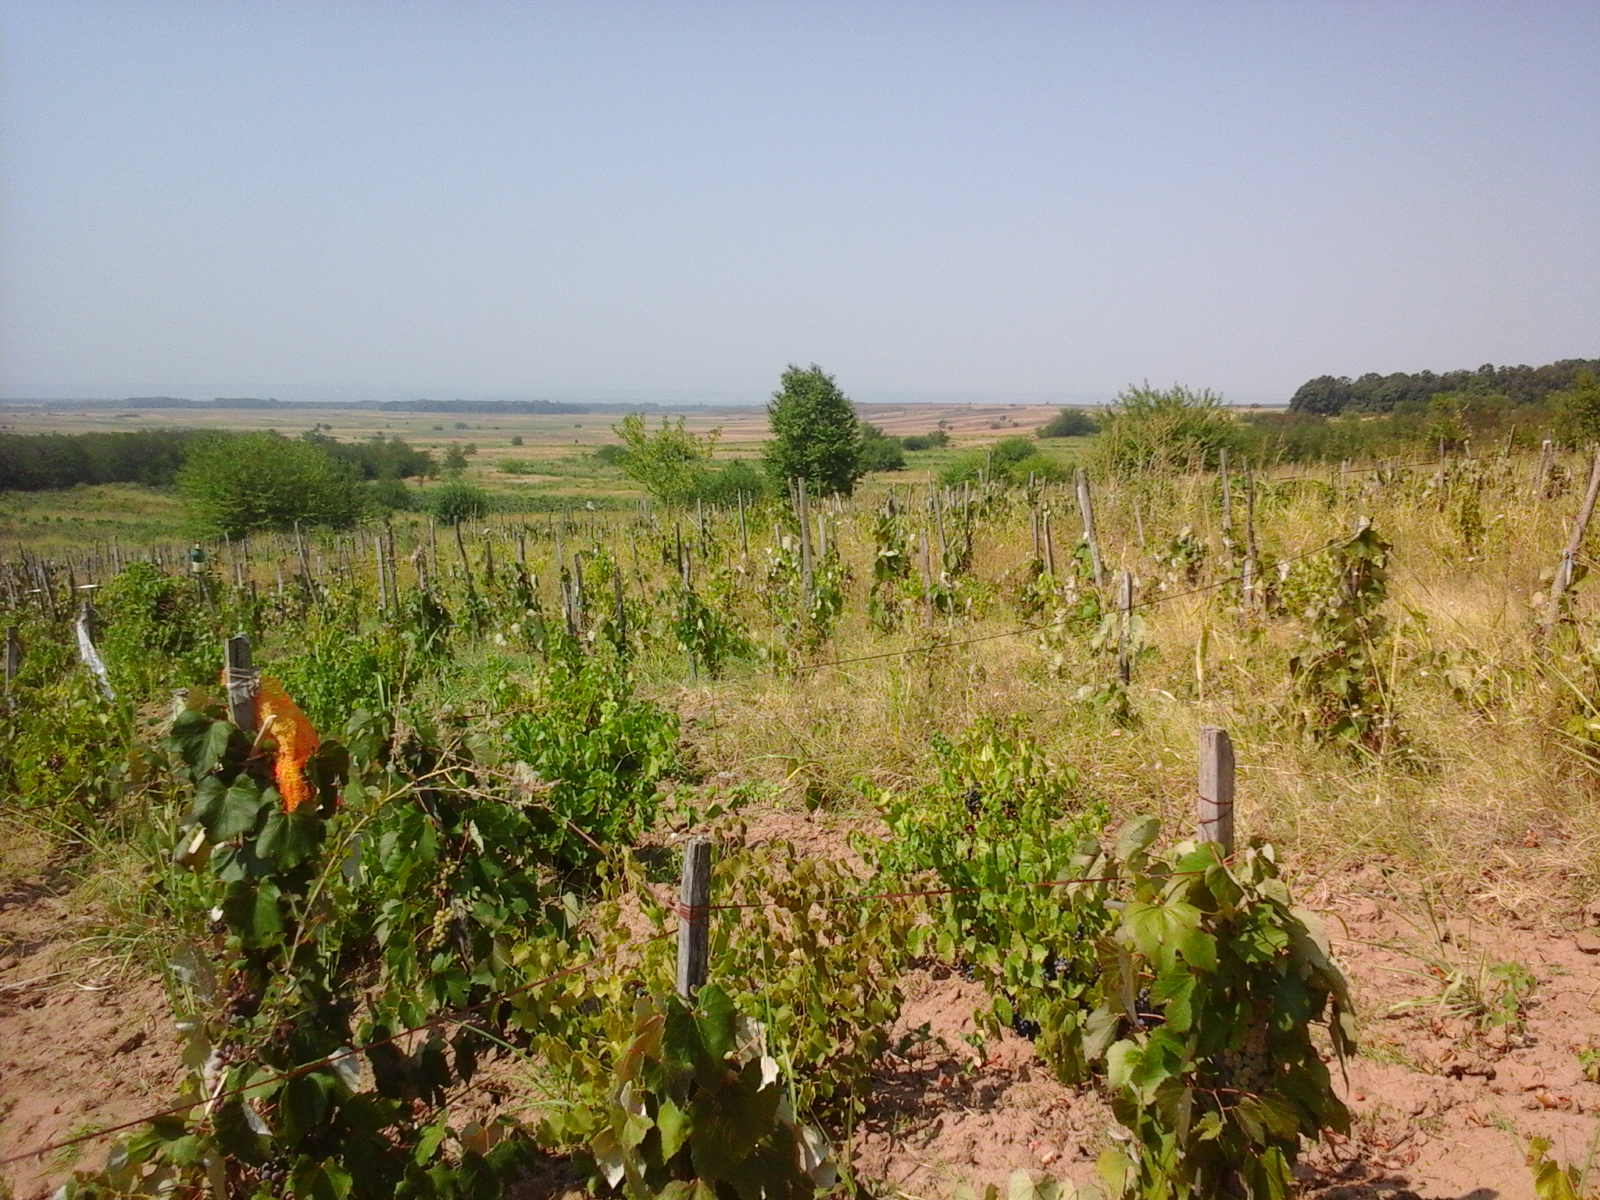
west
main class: Cropland
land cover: Vineyards
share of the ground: > 75 %
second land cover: Spontaneously vegetated surfaces
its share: > 75 %
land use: Agriculture (excluding fallow land and kitchen gardens)
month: August
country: RO
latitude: 44.3690
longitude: 22.7020
